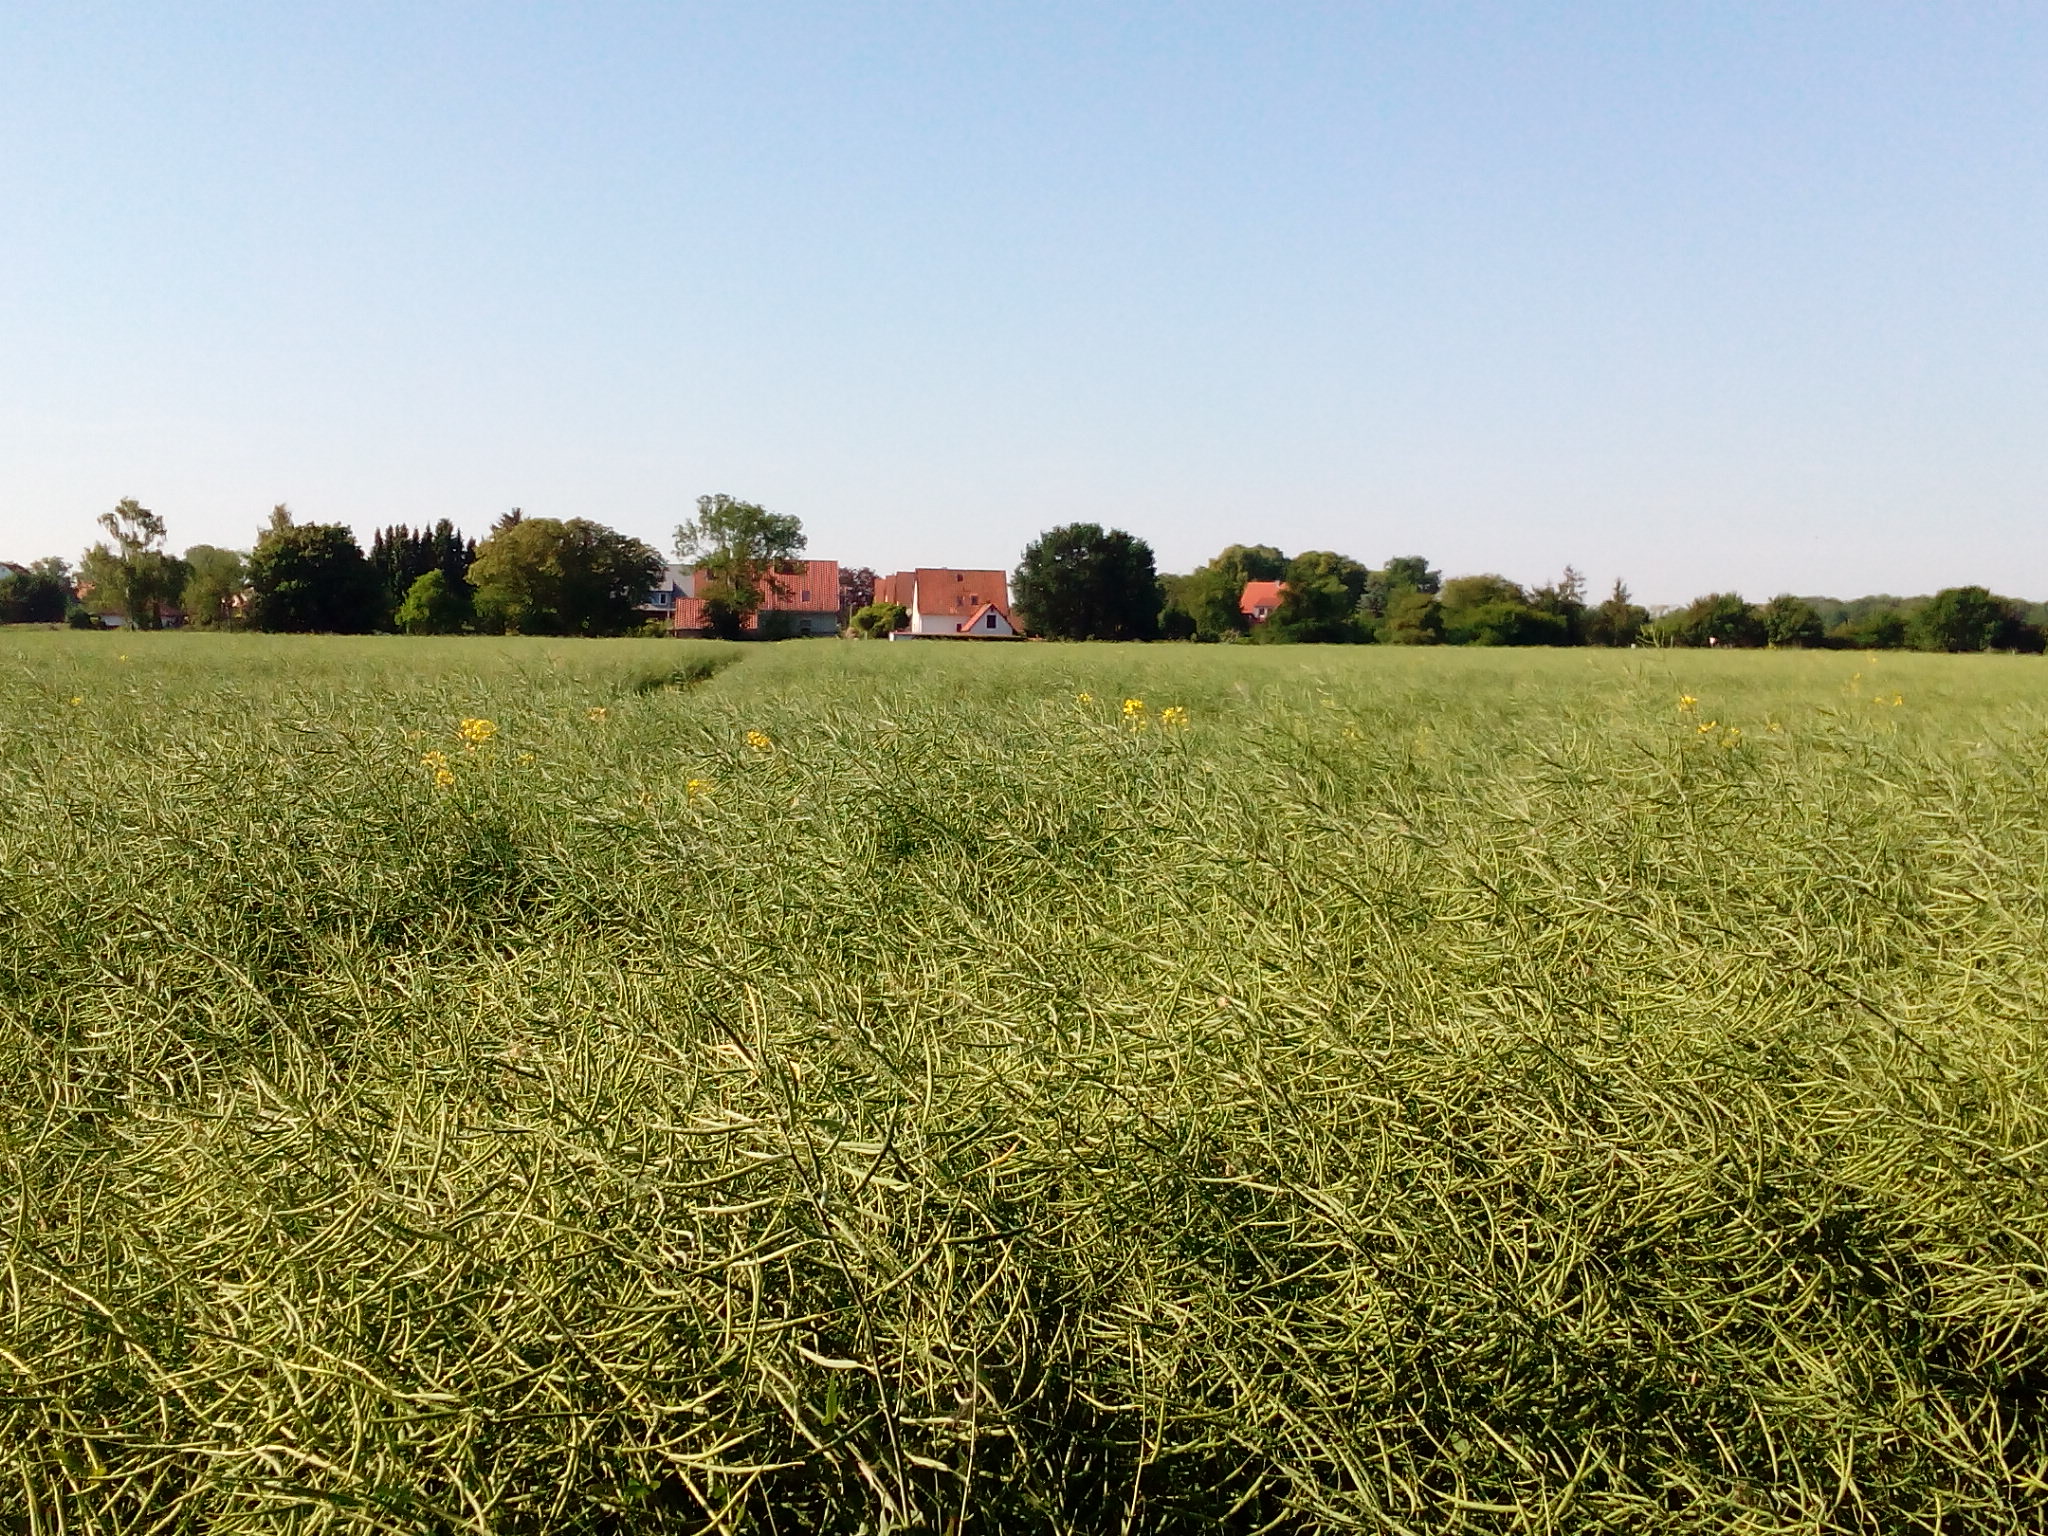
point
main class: Cropland
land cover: Rape and turnip rape
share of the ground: > 75 %
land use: Agriculture (excluding fallow land and kitchen gardens)
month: June
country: DE
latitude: 52.3235
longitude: 9.9267
